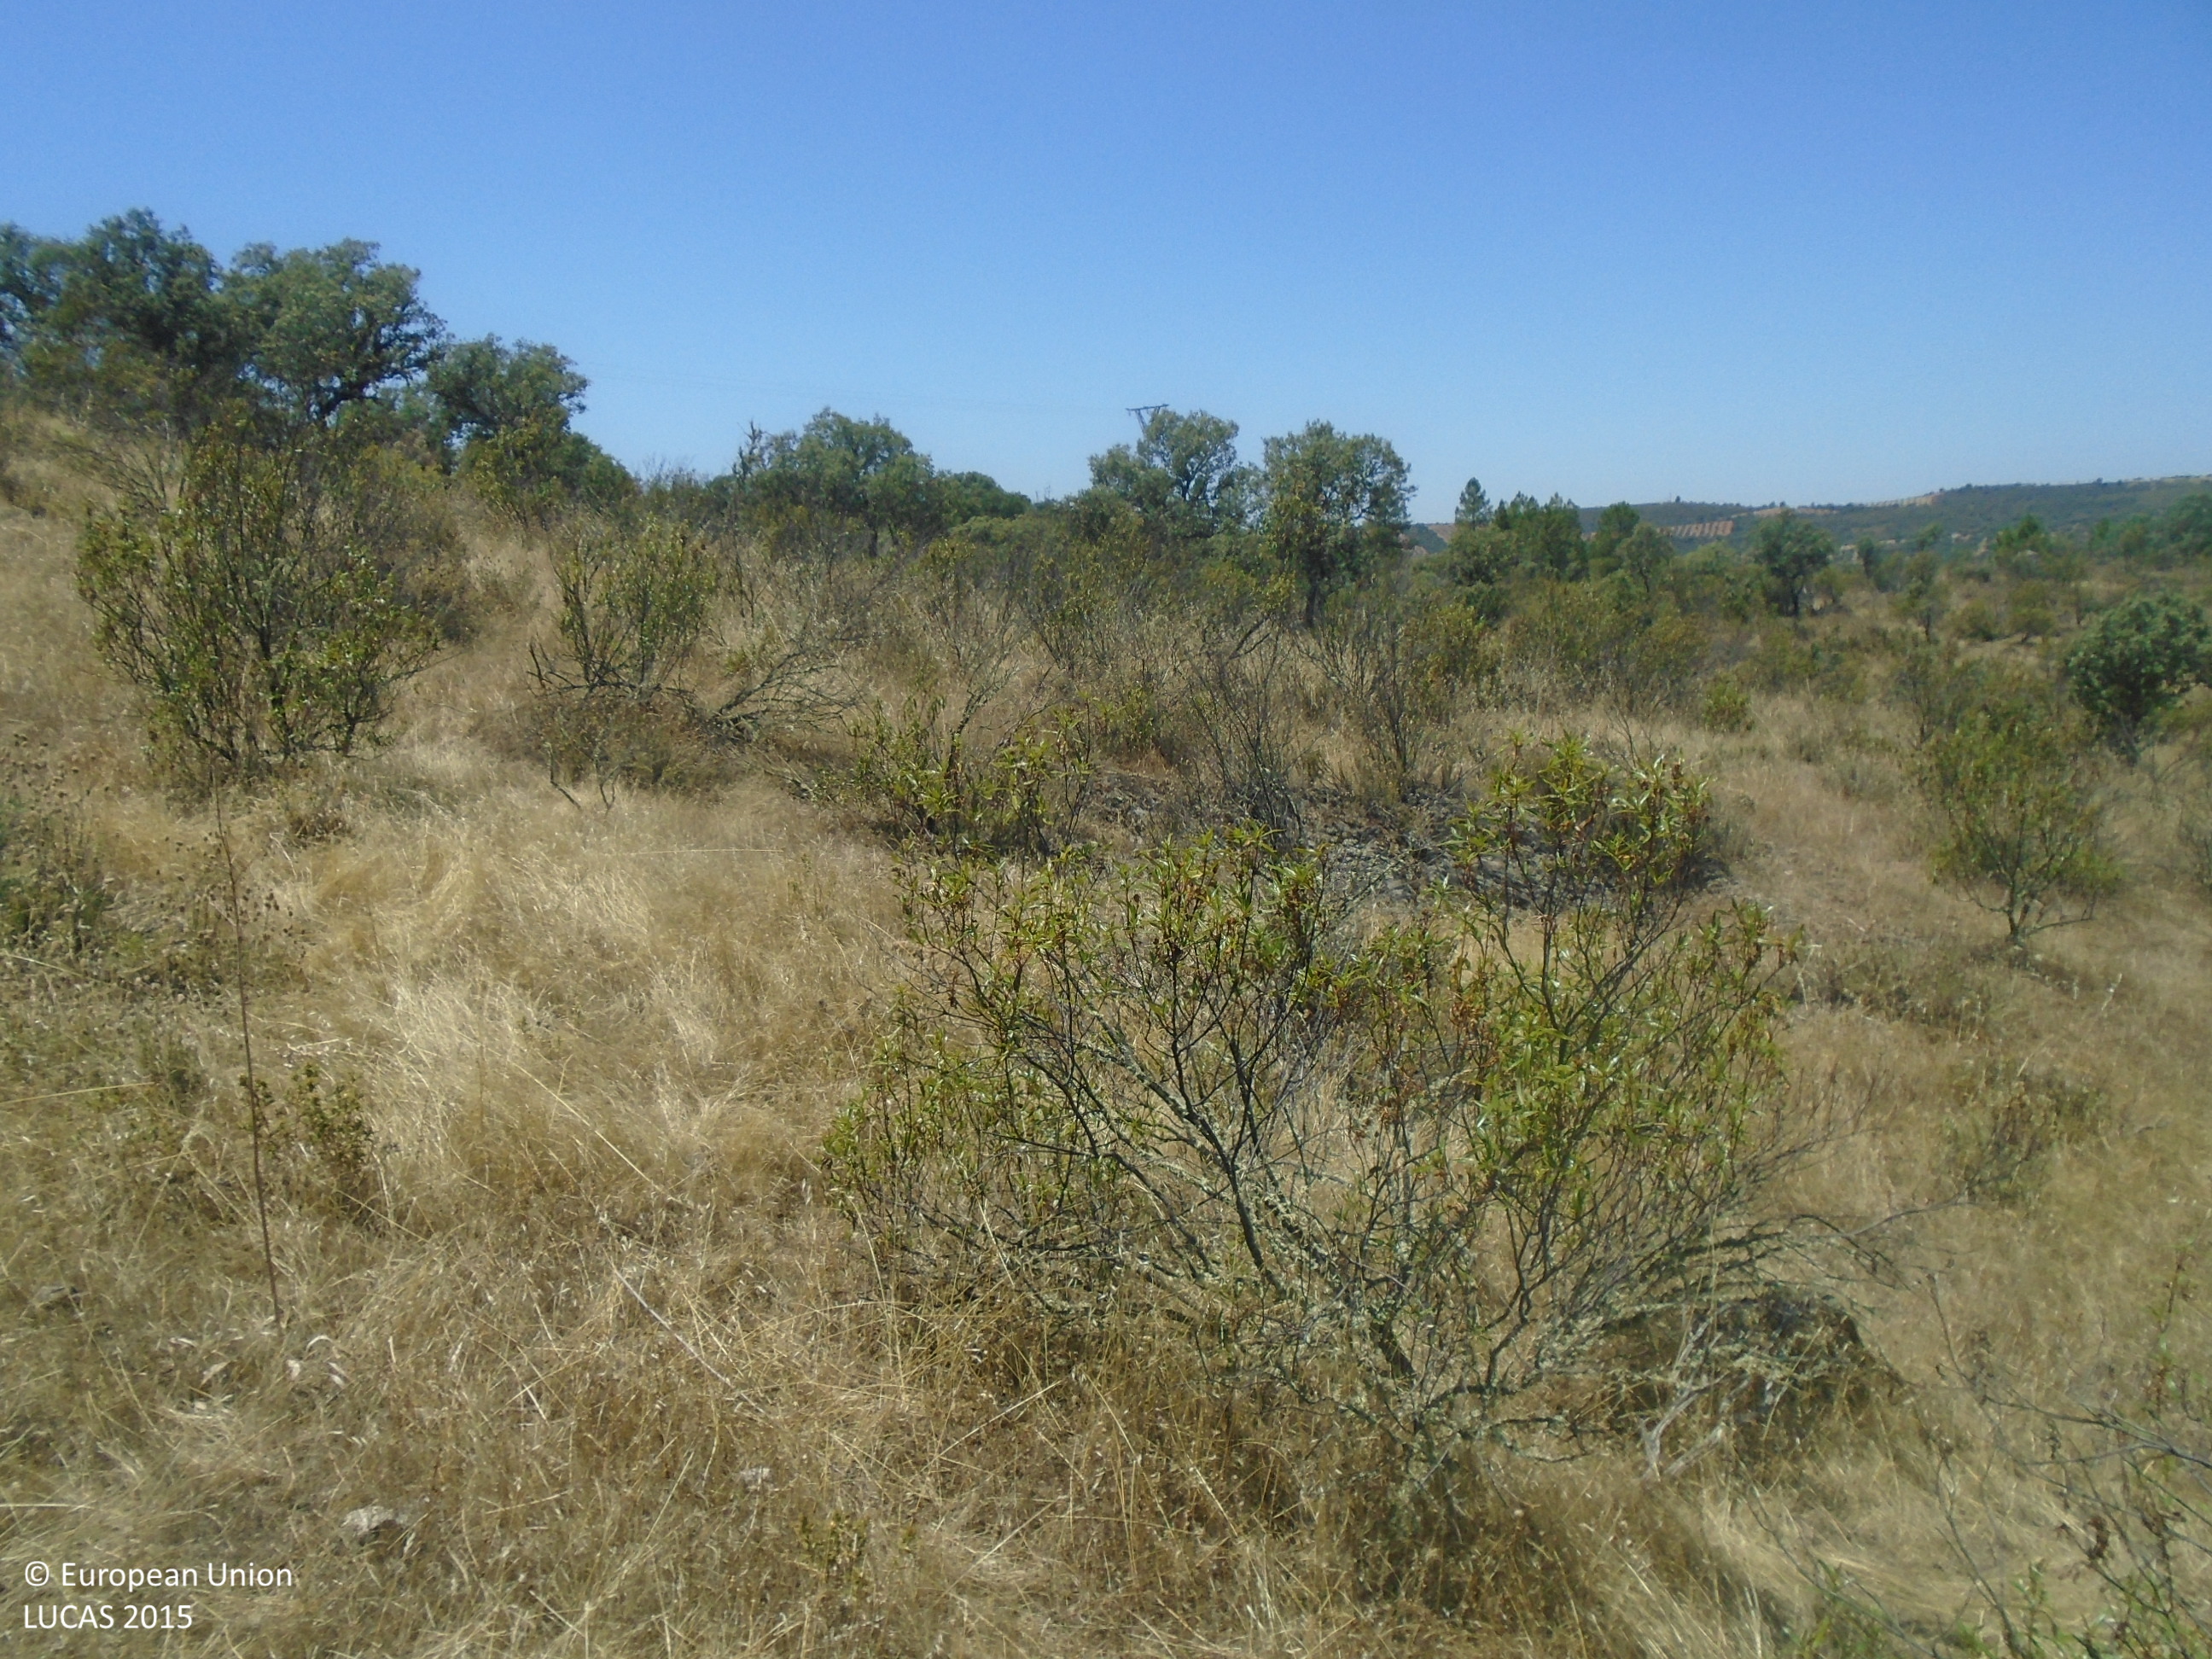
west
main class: Shrubland
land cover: Shrubland with sparse tree cover
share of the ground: > 75 %
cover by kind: shrubs 85 %, broadleaved forest trees 5 %, herbaceous plants 5 %, consolidated bare surface 5 %
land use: Semi-natural and natural areas not in use
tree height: > 5 m
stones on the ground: 10 - 25 %
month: July
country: ES
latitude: 39.4486
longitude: -4.8093
